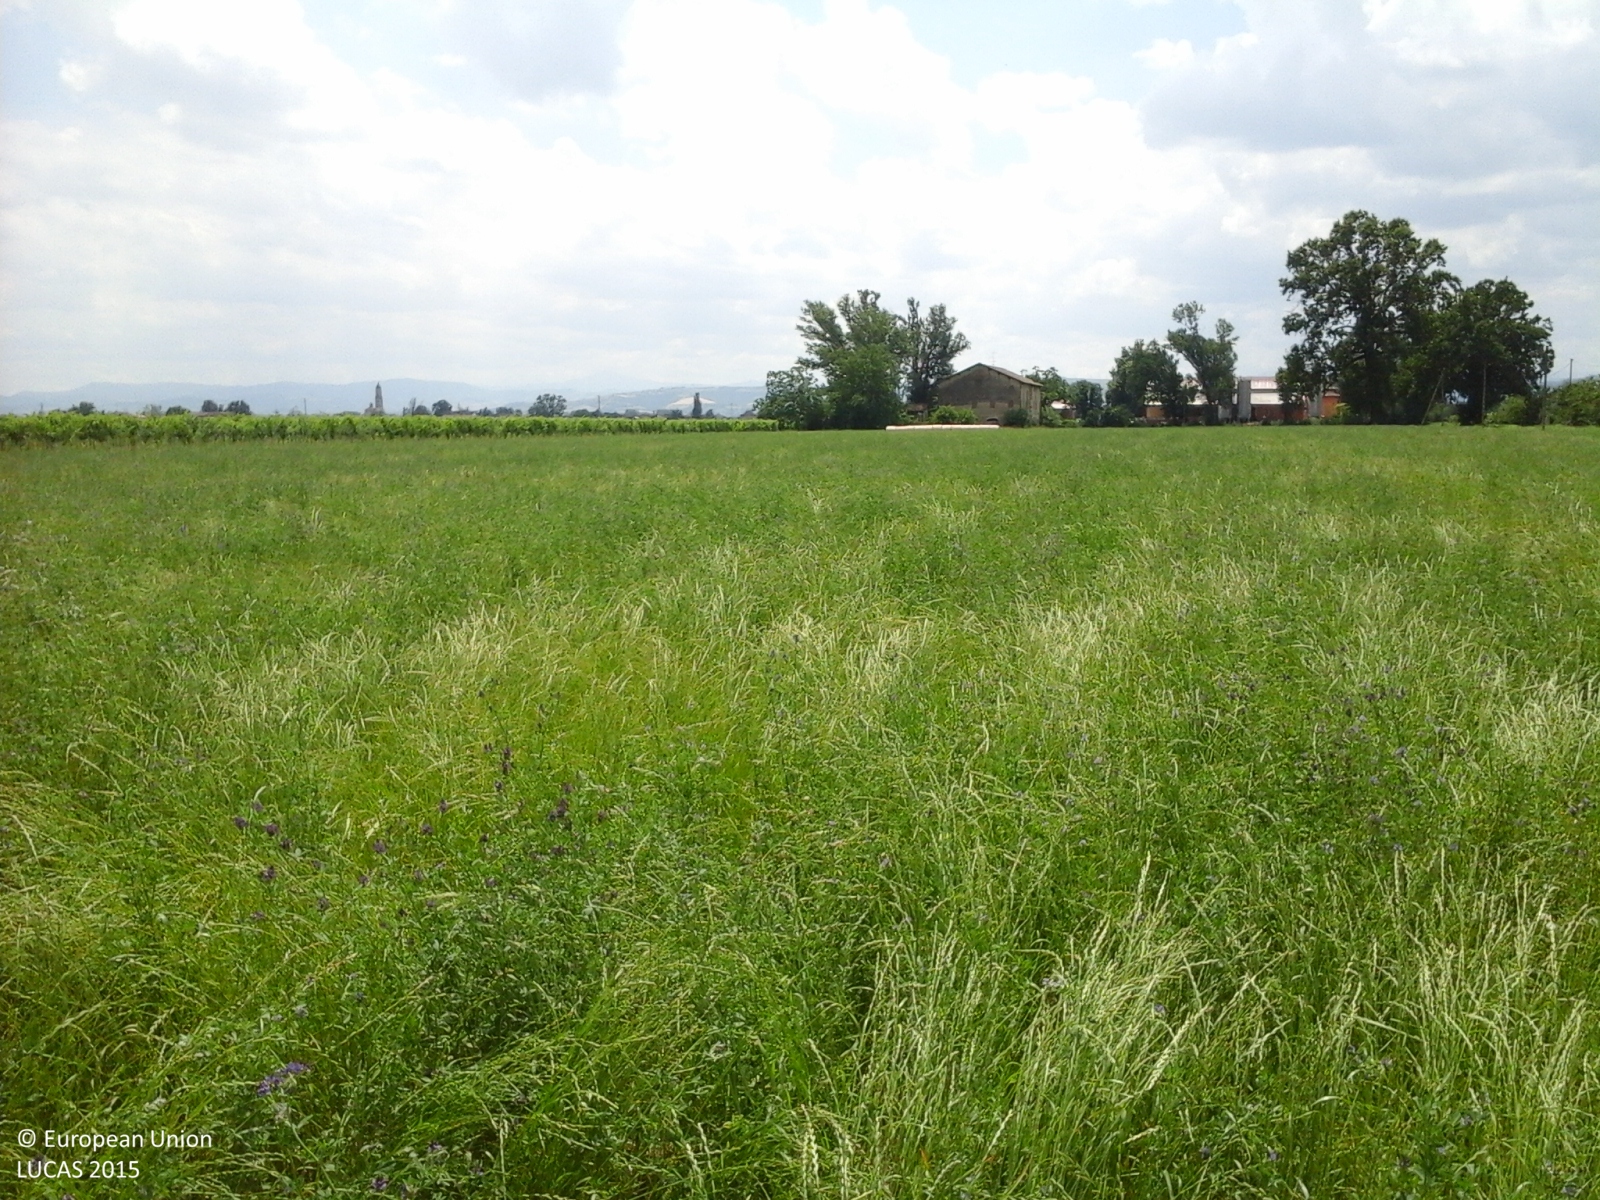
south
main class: Cropland
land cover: Temporary grasslands
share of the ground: > 75 %
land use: Agriculture (excluding fallow land and kitchen gardens)
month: June
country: IT
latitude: 44.6725
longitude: 10.7427
